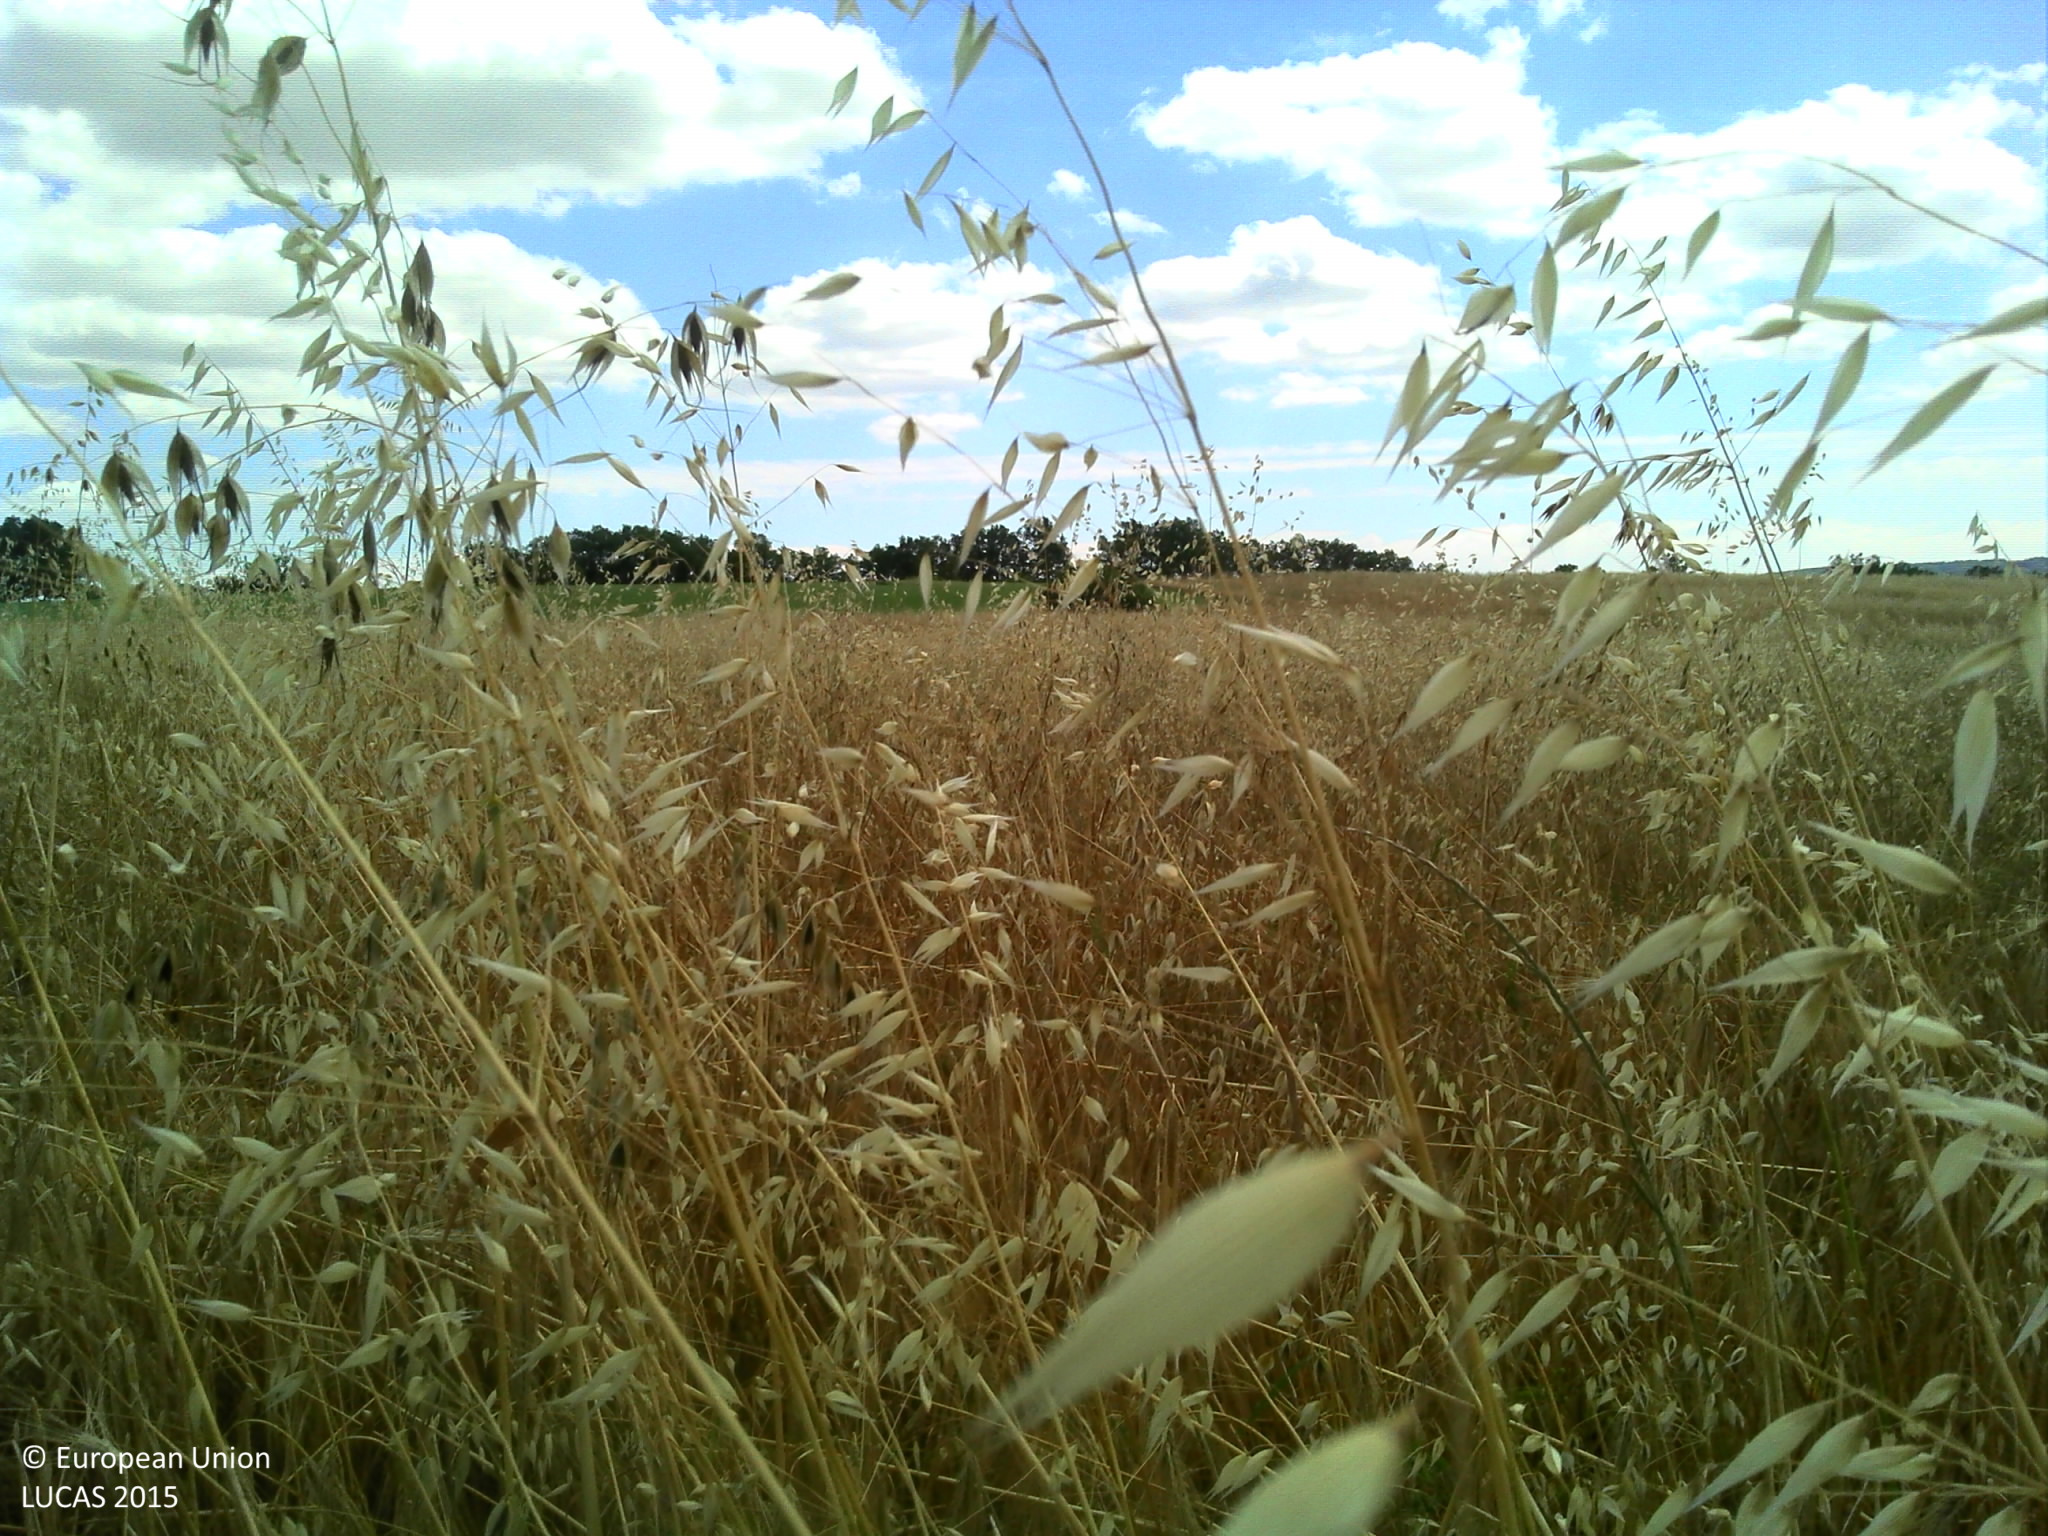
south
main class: Cropland
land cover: Barley
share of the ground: 50 - 75 %
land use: Agriculture (excluding fallow land and kitchen gardens)
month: June
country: FR
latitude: 44.1254
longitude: 1.9163
